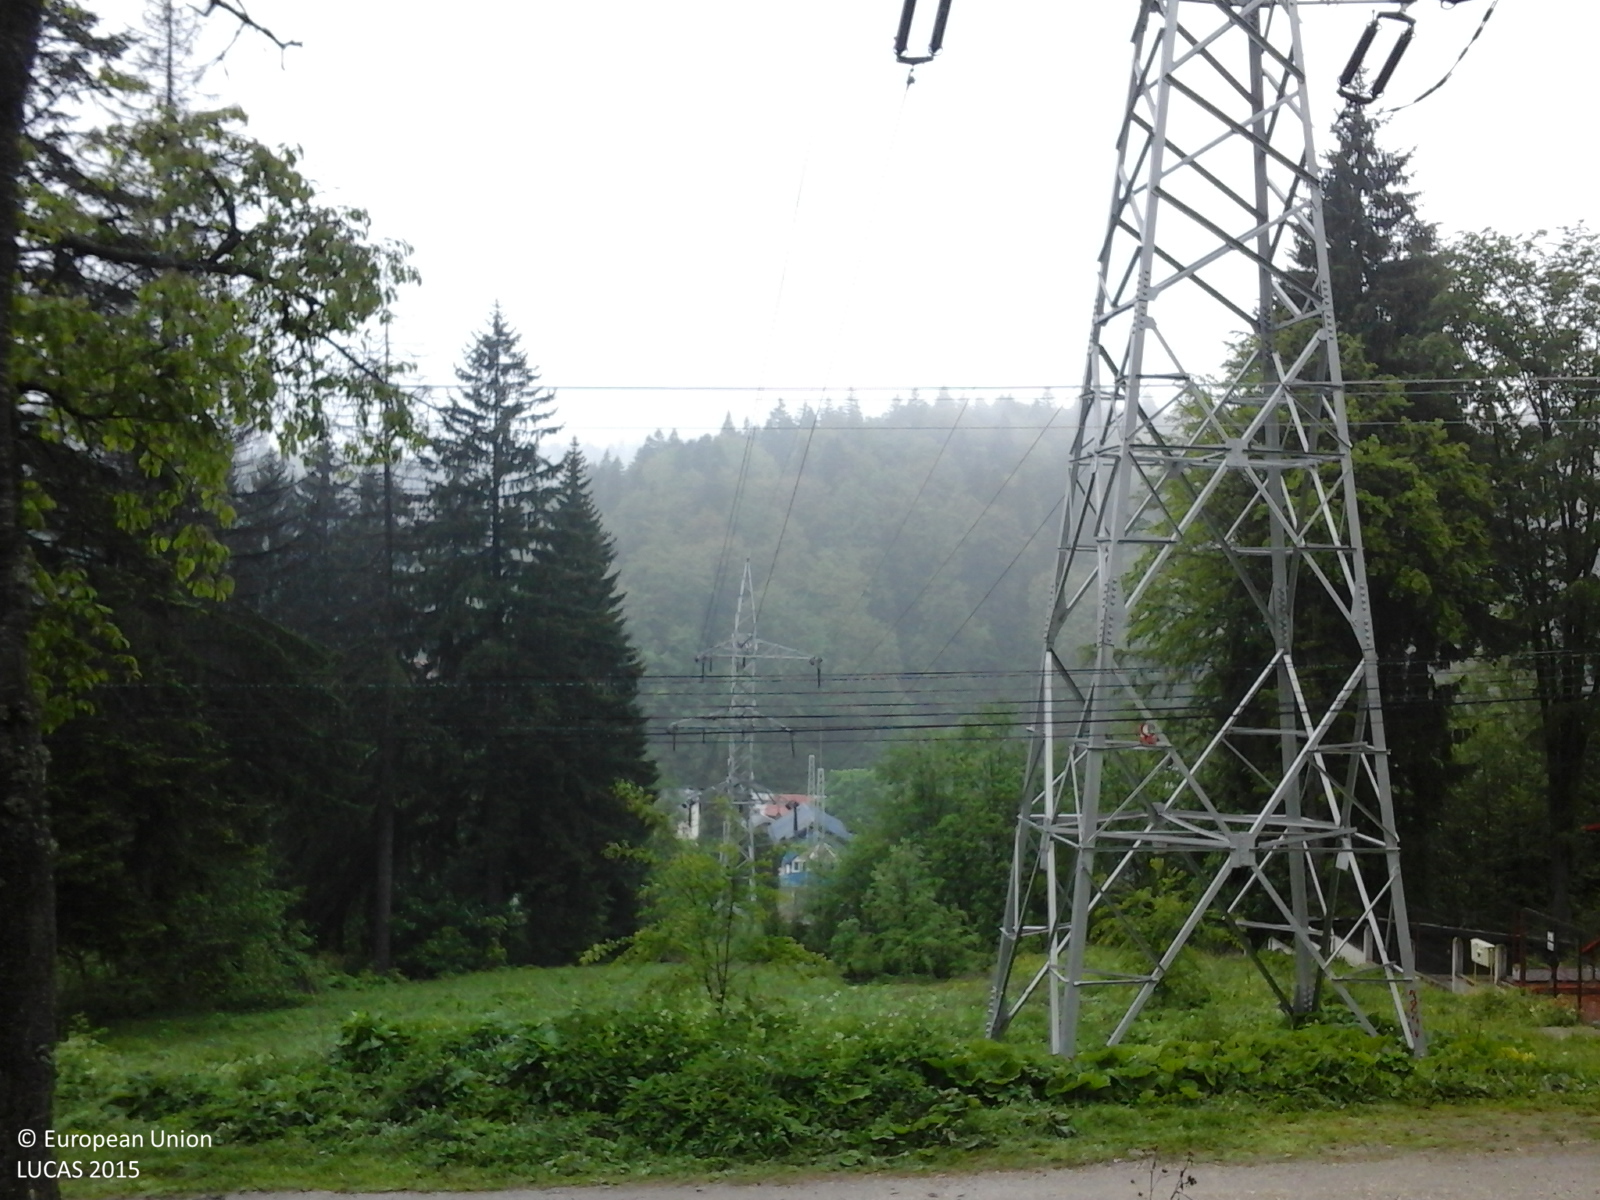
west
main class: Woodland
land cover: Spruce dominated coniferous woodland
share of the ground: > 75 %
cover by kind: coniferous forest trees 80 %, herbaceous plants 20 %
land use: Forestry
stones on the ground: < 10 %
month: May
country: RO
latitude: 45.4950
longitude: 25.5735
